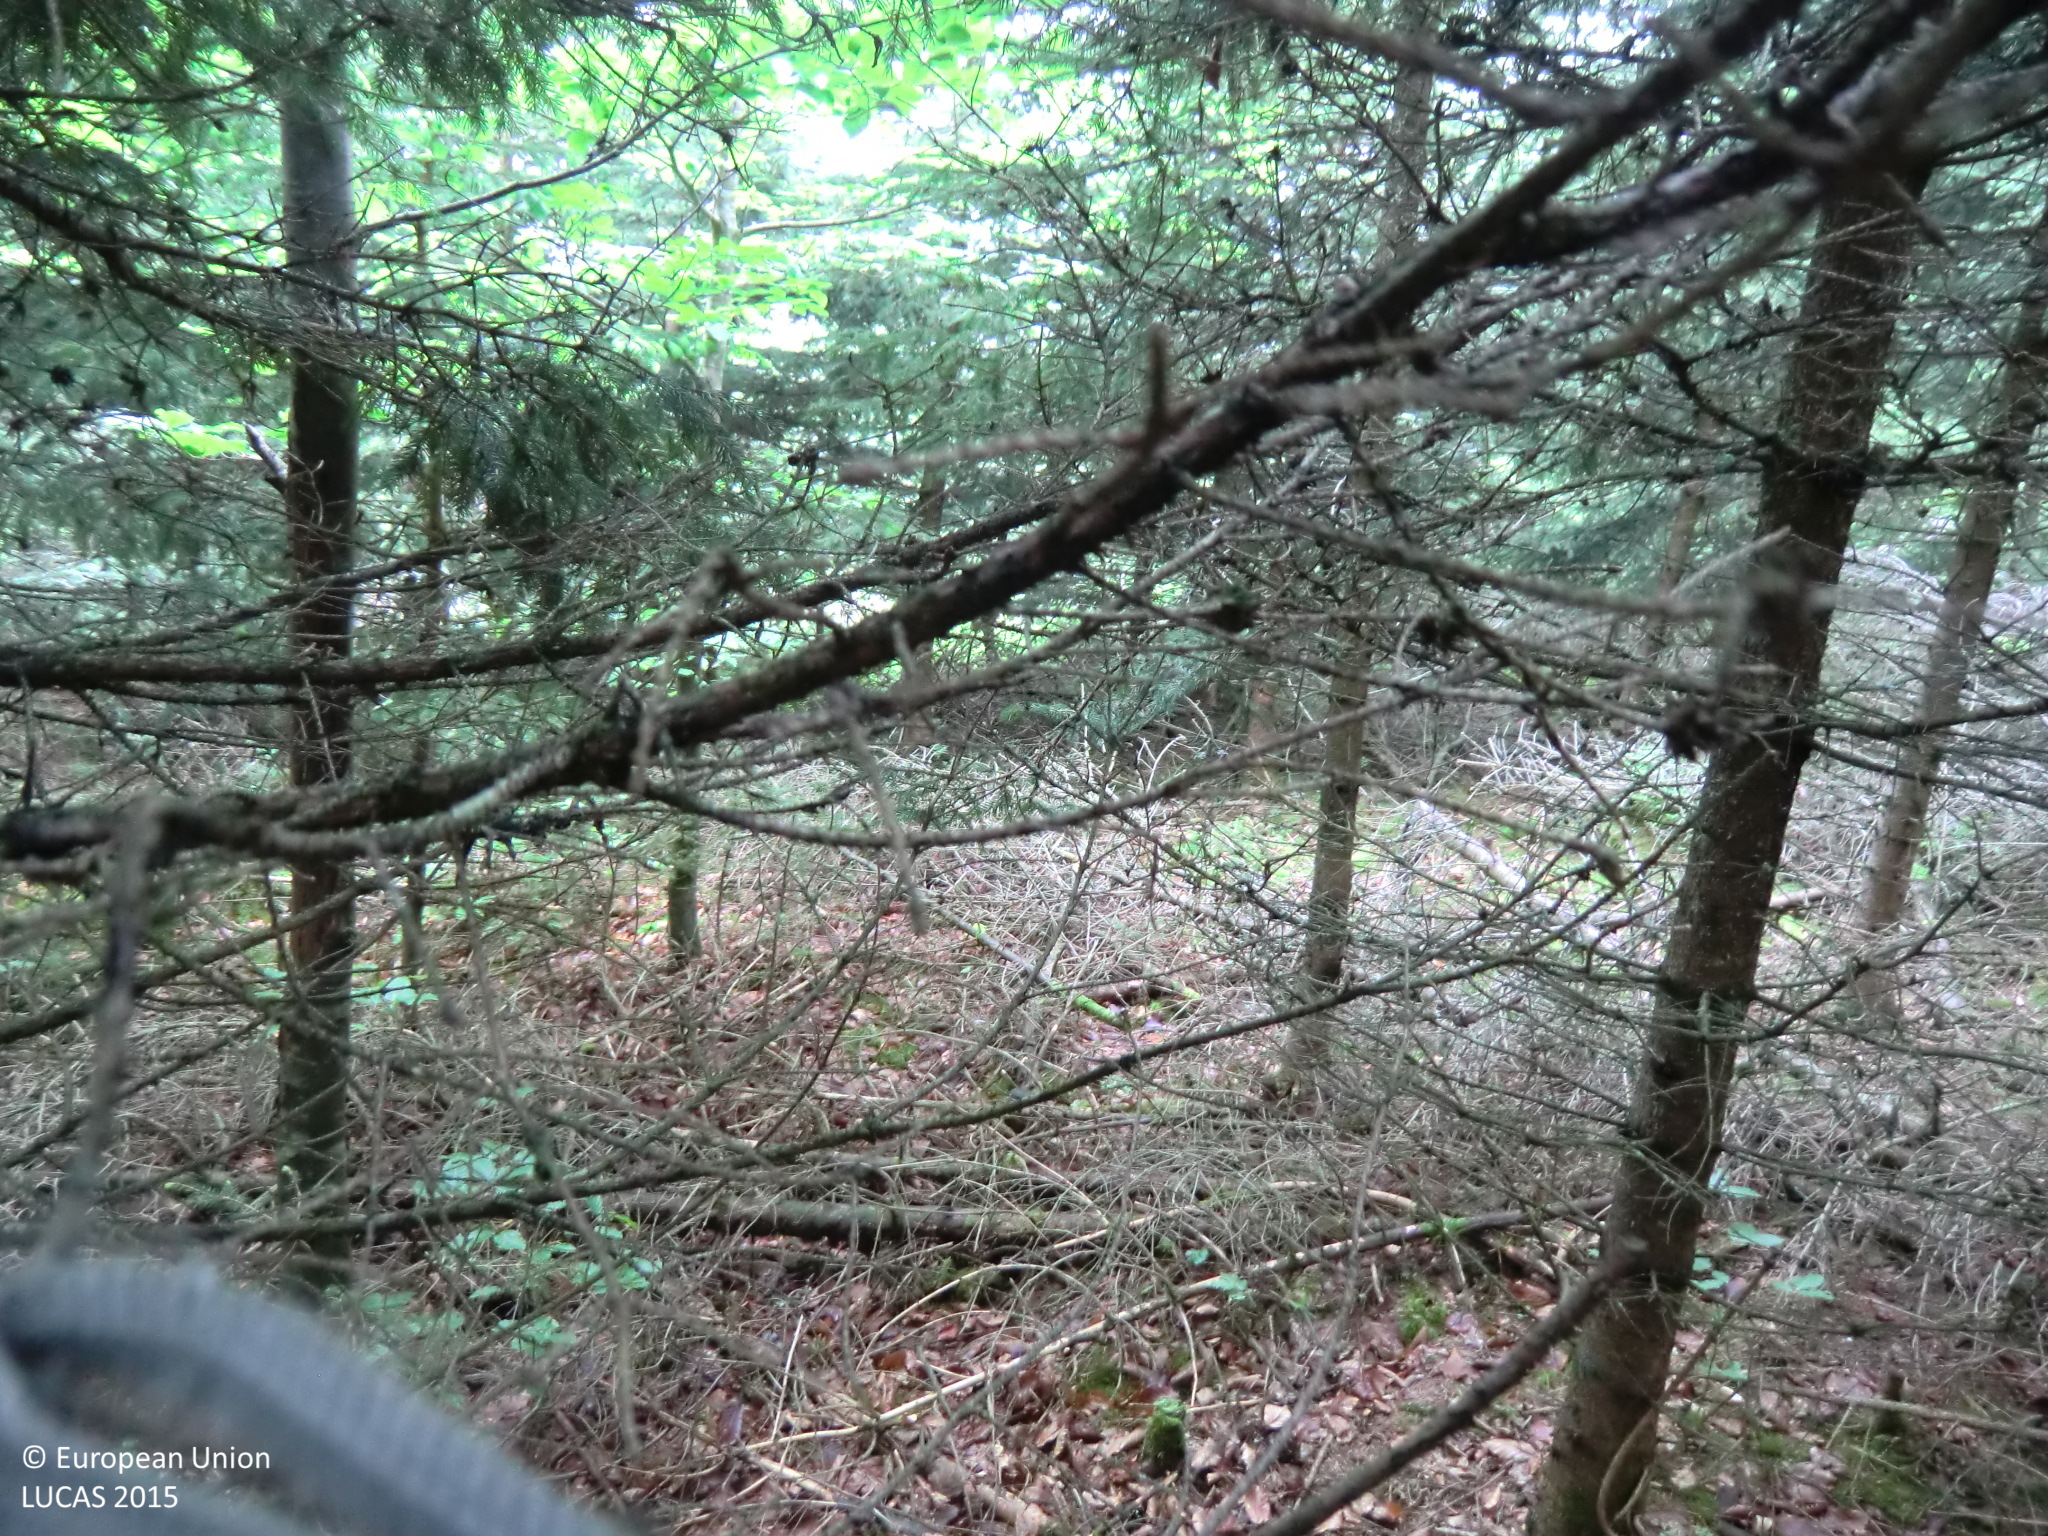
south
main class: Woodland
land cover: Spruce dominated mixed woodland
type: hemiboreal forest and nemoral coniferous forest and mixed broadleaved-coniferous forest
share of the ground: > 75 %
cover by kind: coniferous forest trees 50 %, broadleaved forest trees 30 %, shrubs 20 %
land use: Forestry
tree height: > 5 m
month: May
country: AT
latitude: 48.3992
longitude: 14.9855
